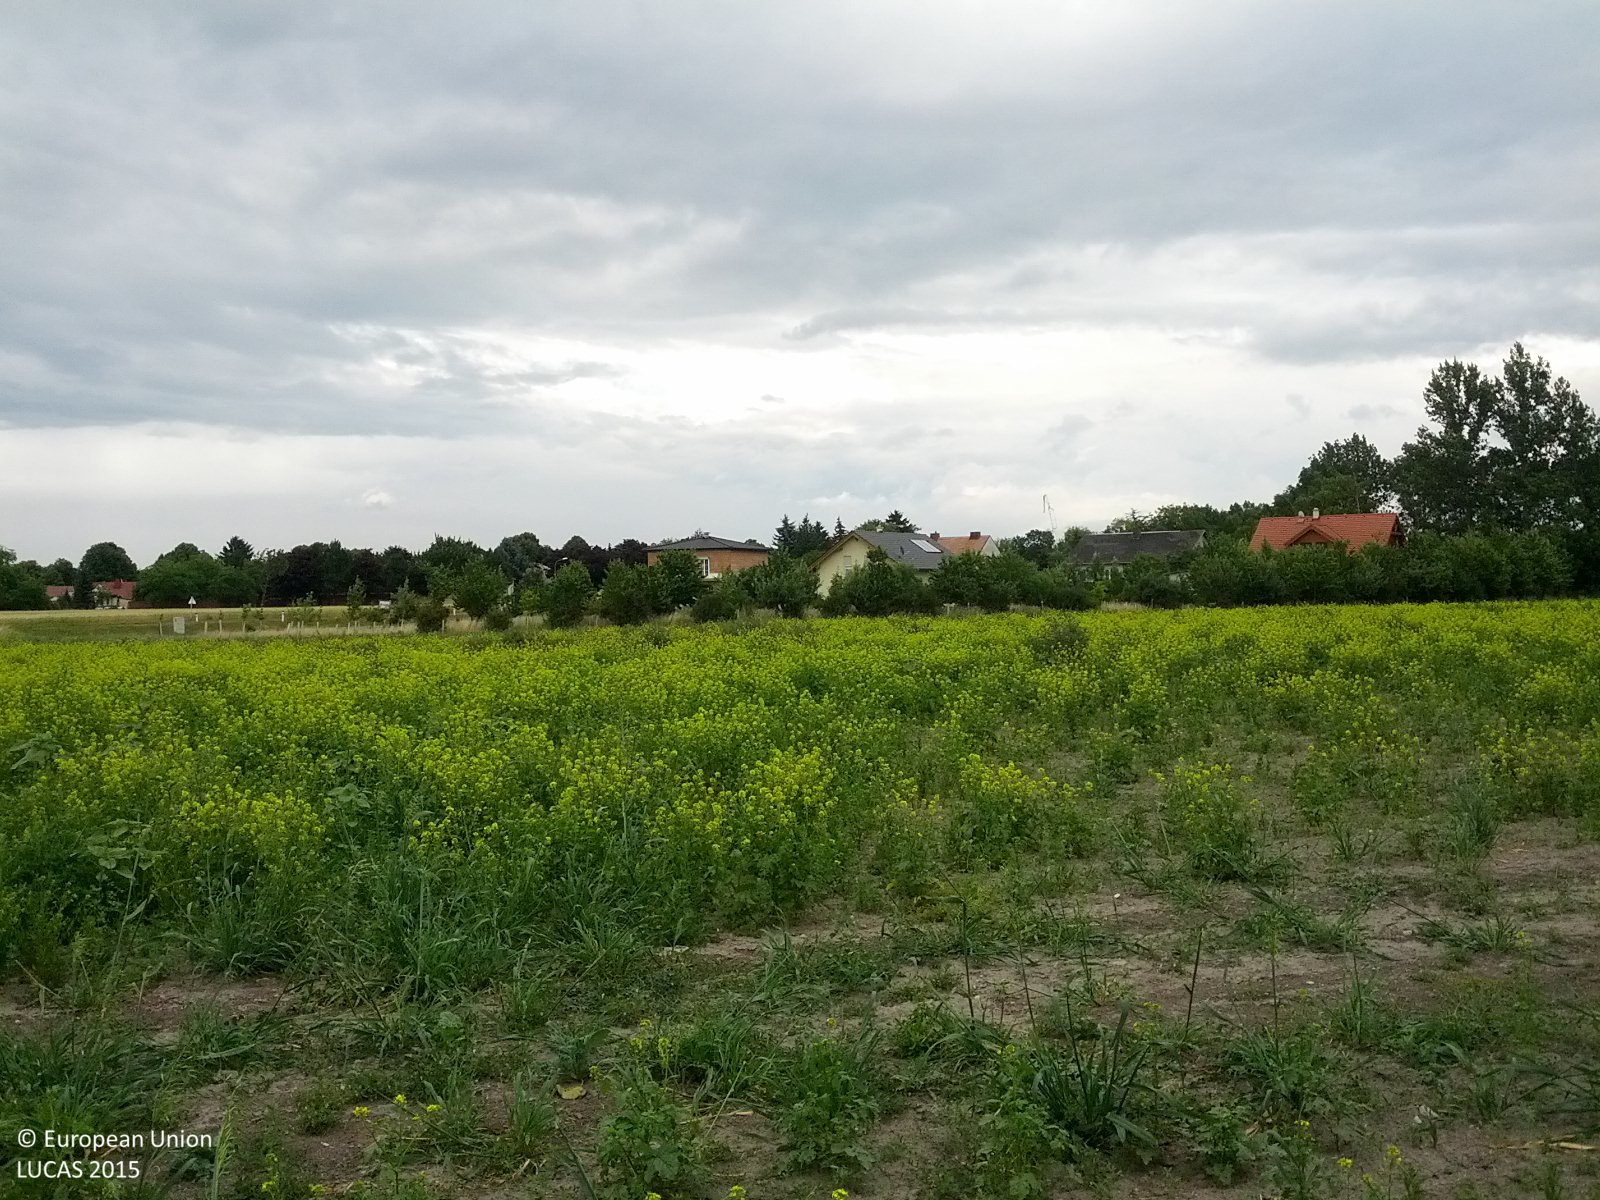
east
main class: Grassland
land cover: Spontaneously vegetated surfaces
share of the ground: > 75 %
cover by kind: herbaceous plants 95 %, unconsolidated bare surface 5 %
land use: Agriculture (excluding fallow land and kitchen gardens)
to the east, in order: Spontaneously vegetated surfaces; Grassland without tree/shrub cover; Cherry fruit; Grassland without tree/shrub cover; Paved roads, cycling and walking lanes; Grass margins; Triticale; Grass margins; Artificial constructions in urban areas
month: June
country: AT
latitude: 48.1957
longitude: 16.7736
